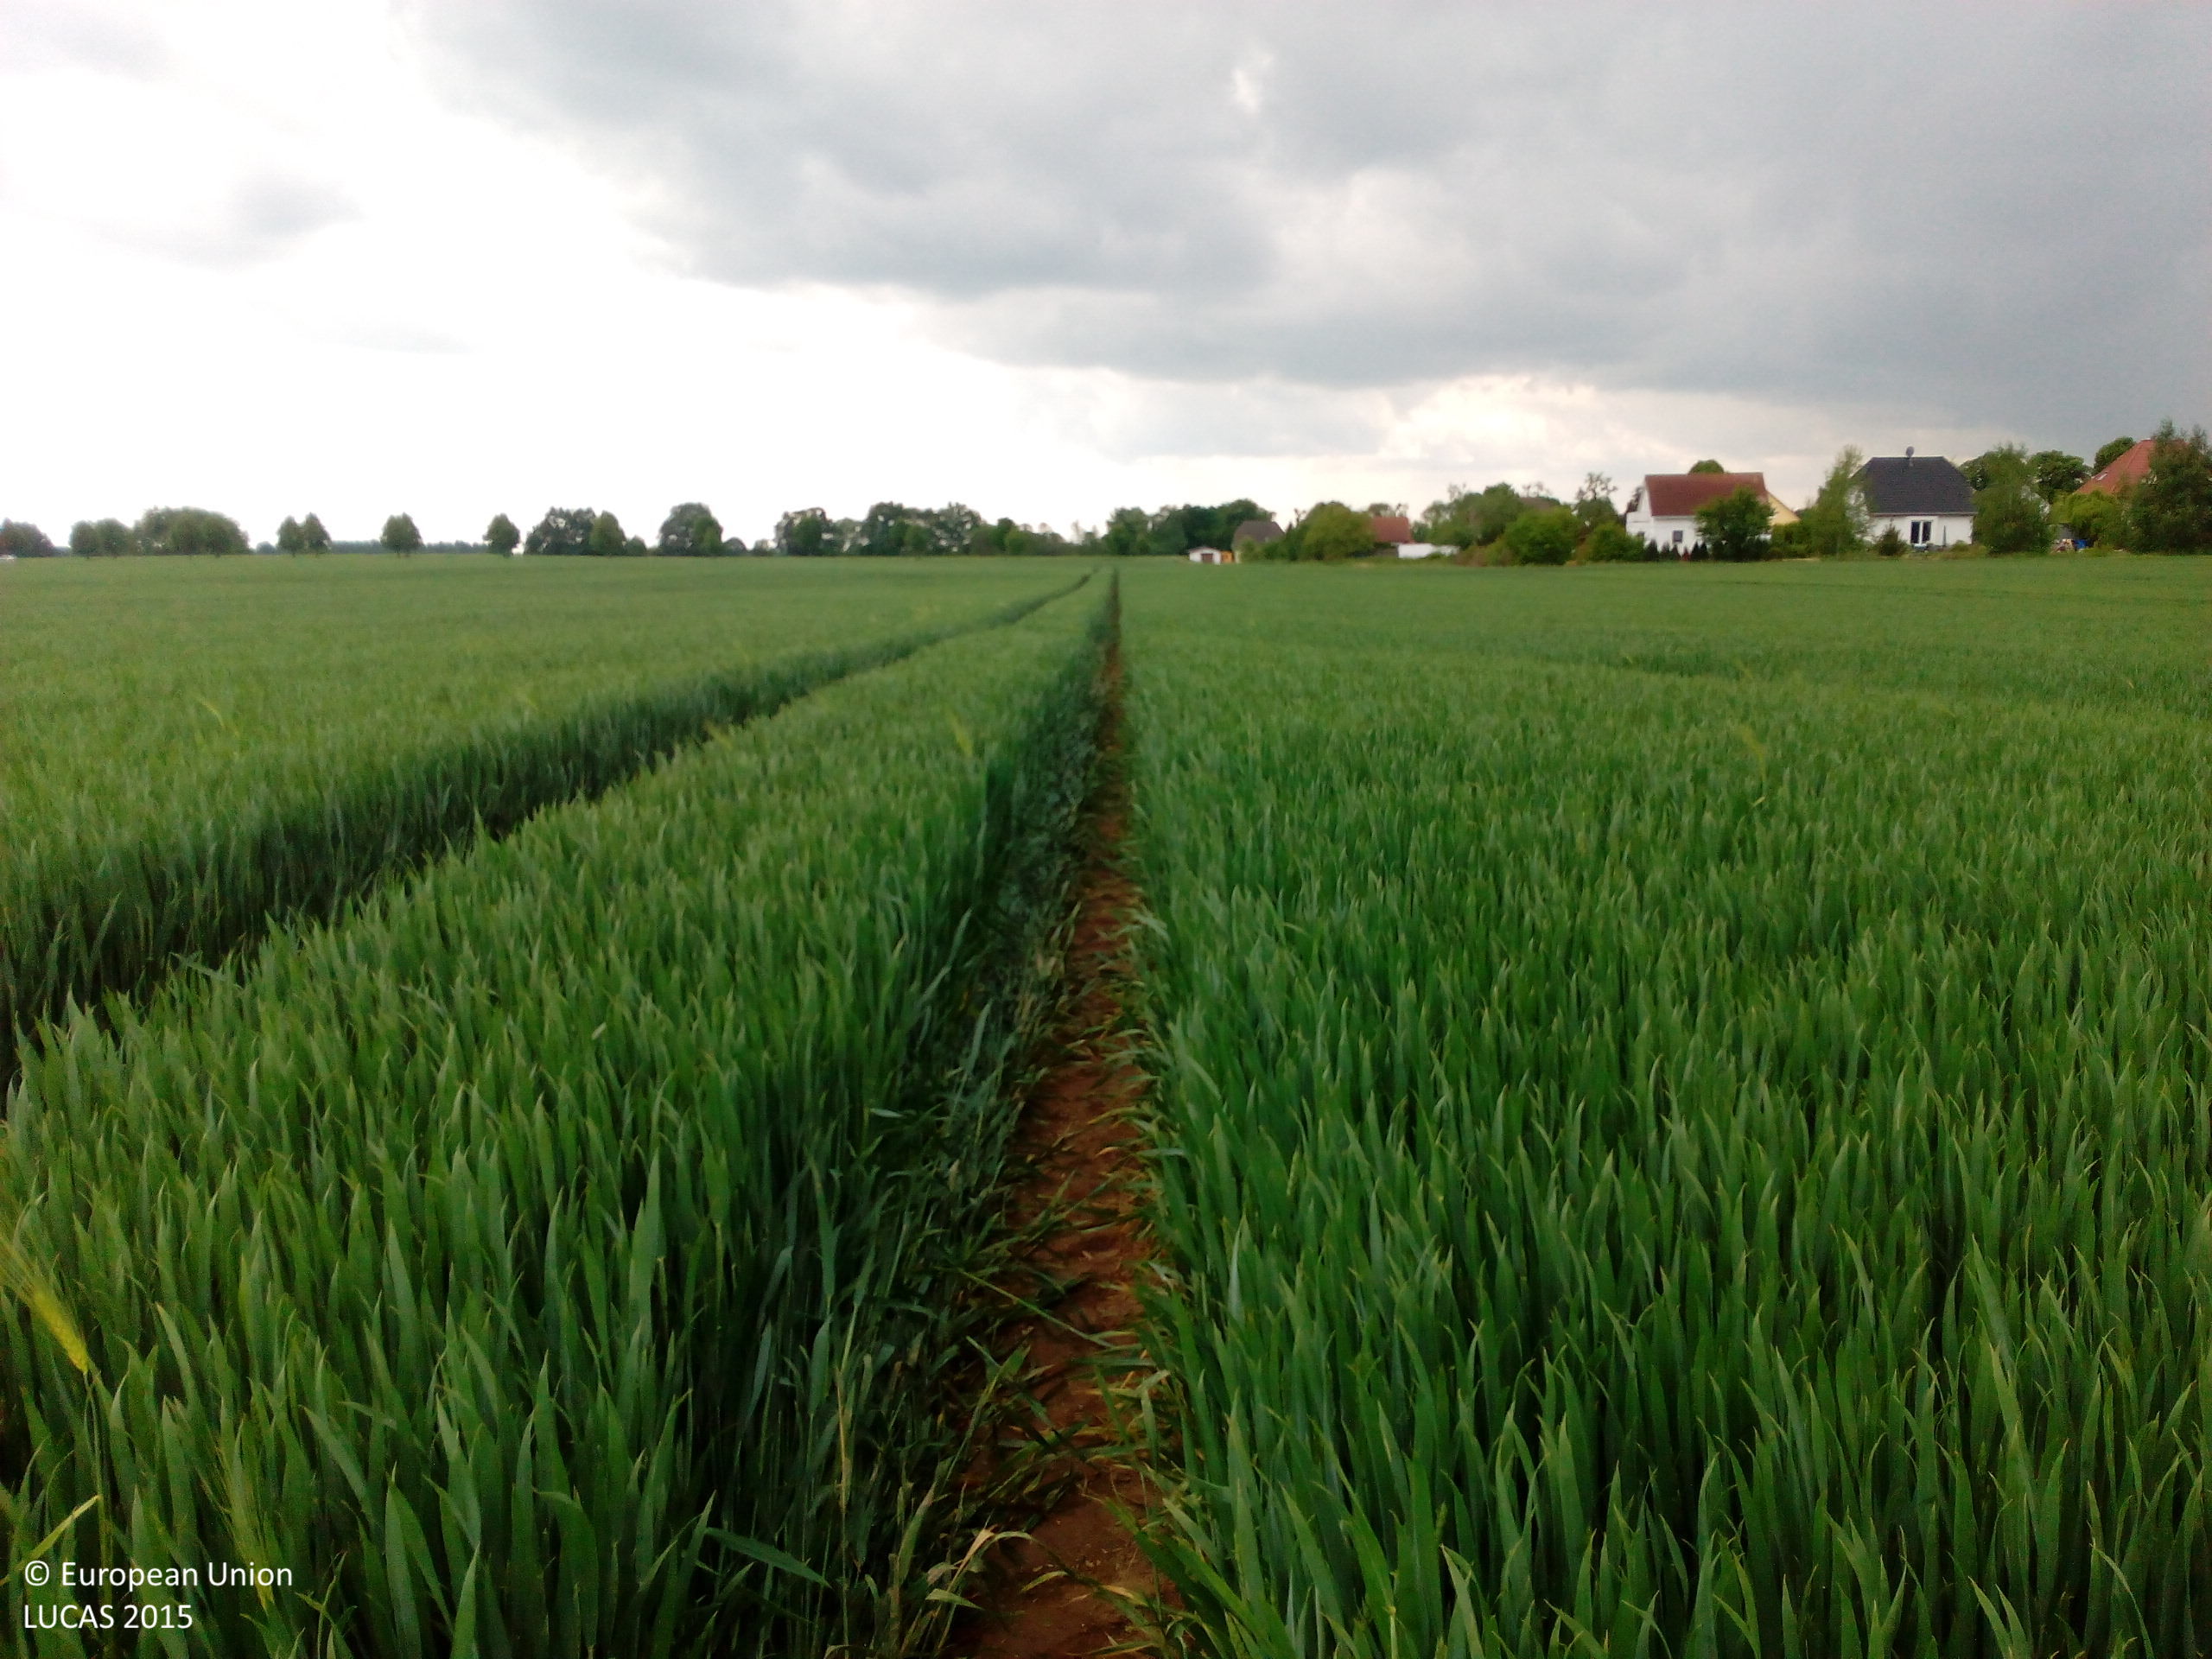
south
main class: Cropland
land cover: Common wheat
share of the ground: > 75 %
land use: Agriculture (excluding fallow land and kitchen gardens)
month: May
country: DE
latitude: 51.5947
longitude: 12.5549
